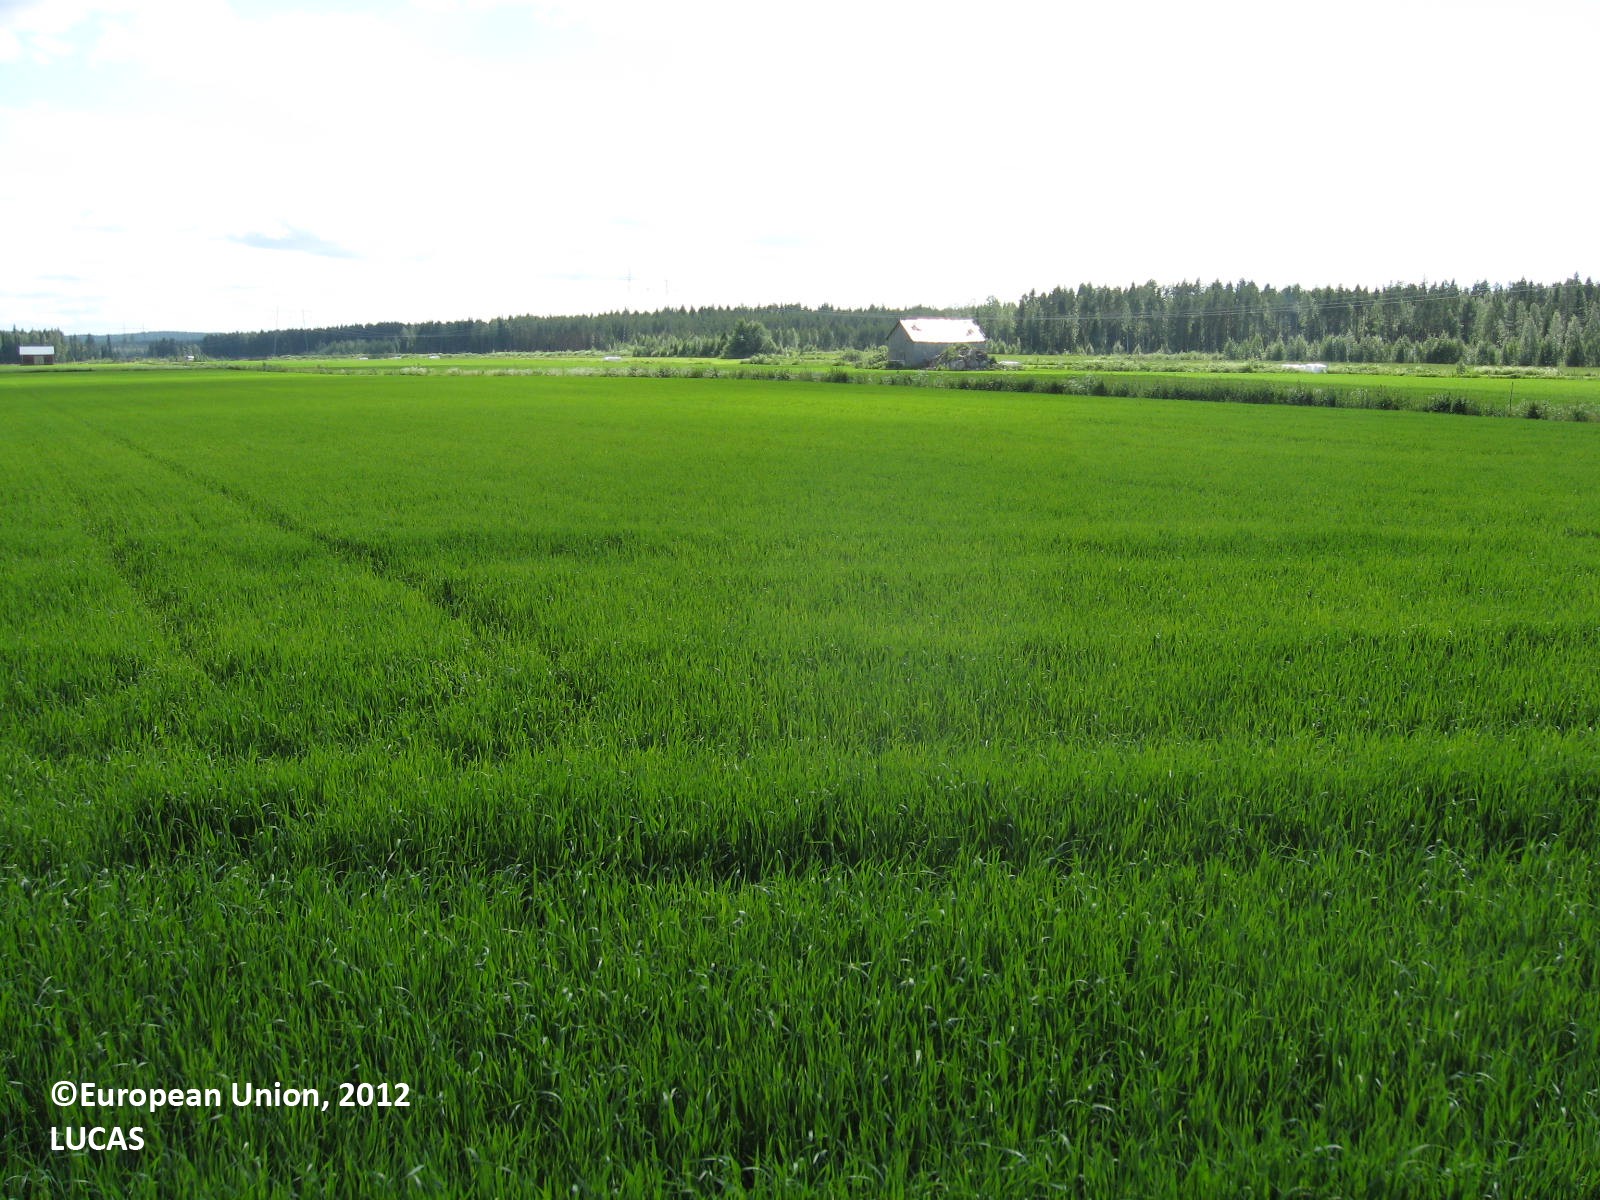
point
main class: Cropland
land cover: Oats
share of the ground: > 75 %
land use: Agriculture (excluding fallow land and kitchen gardens)
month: July
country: FI
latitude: 62.7010
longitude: 22.6227
